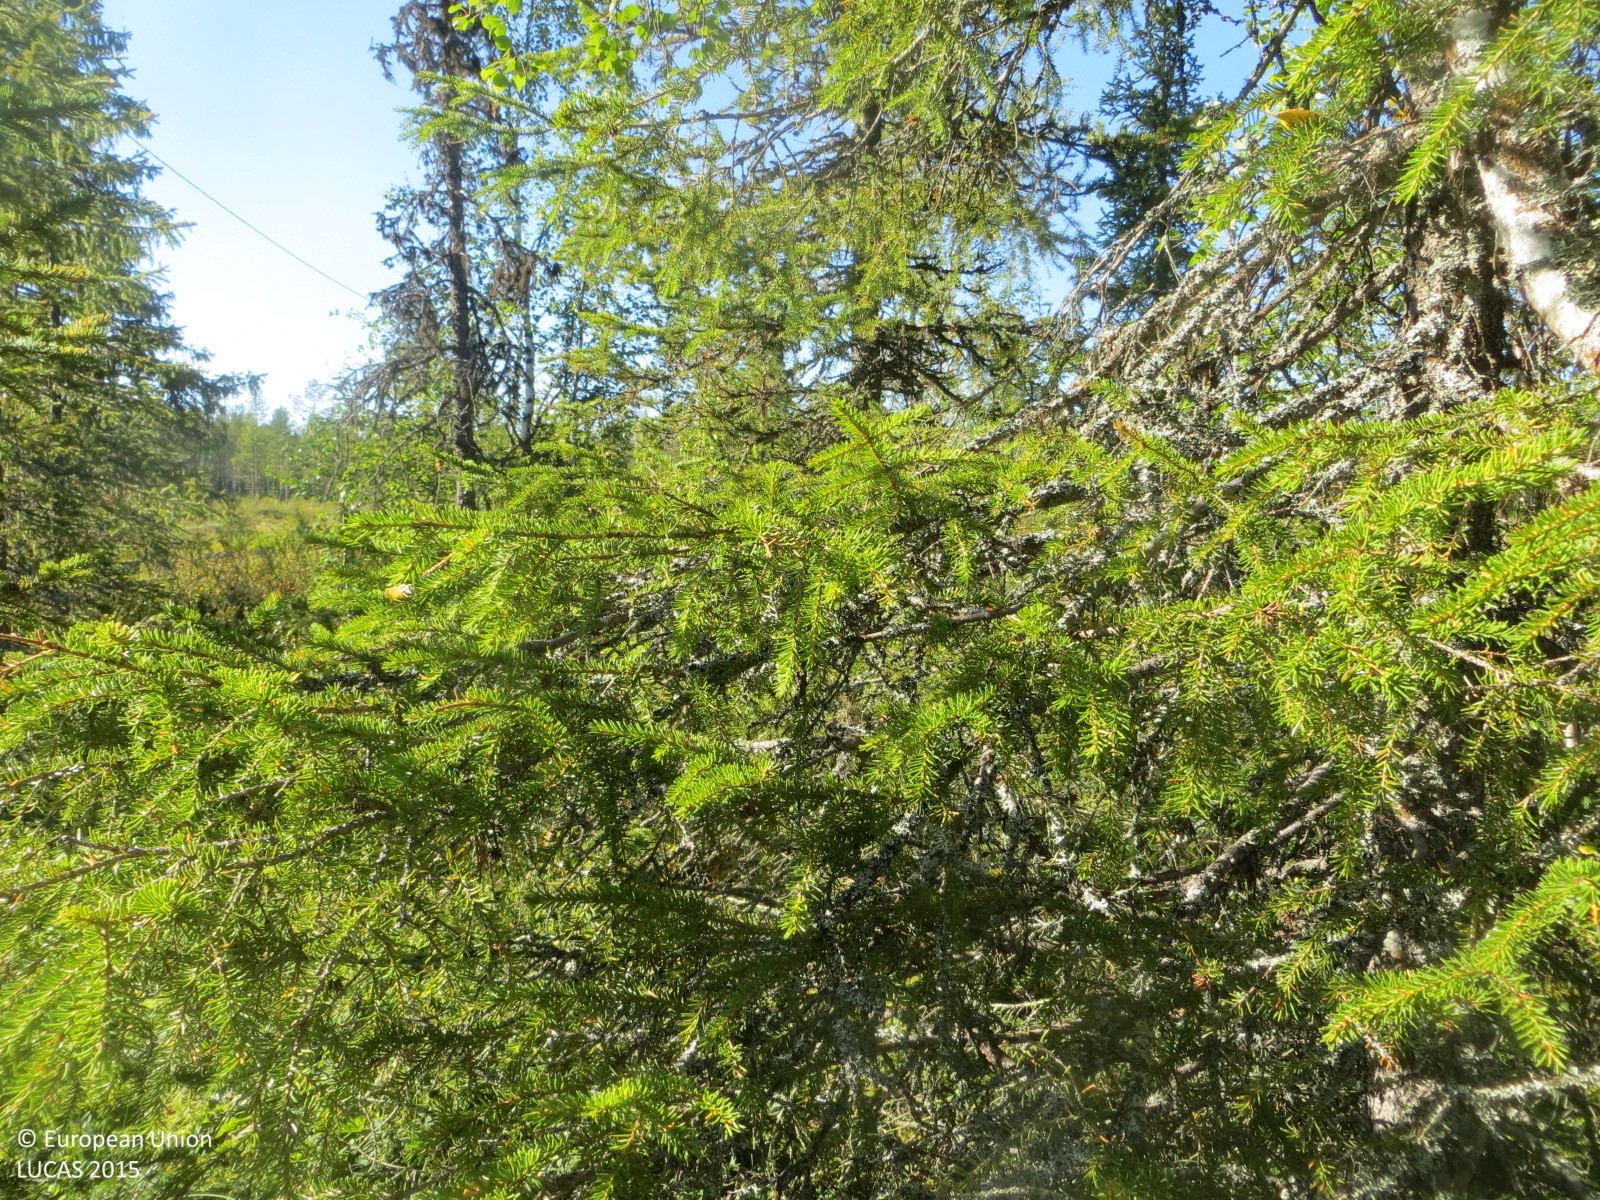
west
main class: Woodland
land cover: Spruce dominated mixed woodland
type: mire and swamp forests
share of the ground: 50 - 75 %
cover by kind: broadleaved forest trees 35 %, shrubs 35 %, coniferous forest trees 30 %
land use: Forestry
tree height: > 5 m
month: August
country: FI
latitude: 67.6148
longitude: 24.1654
